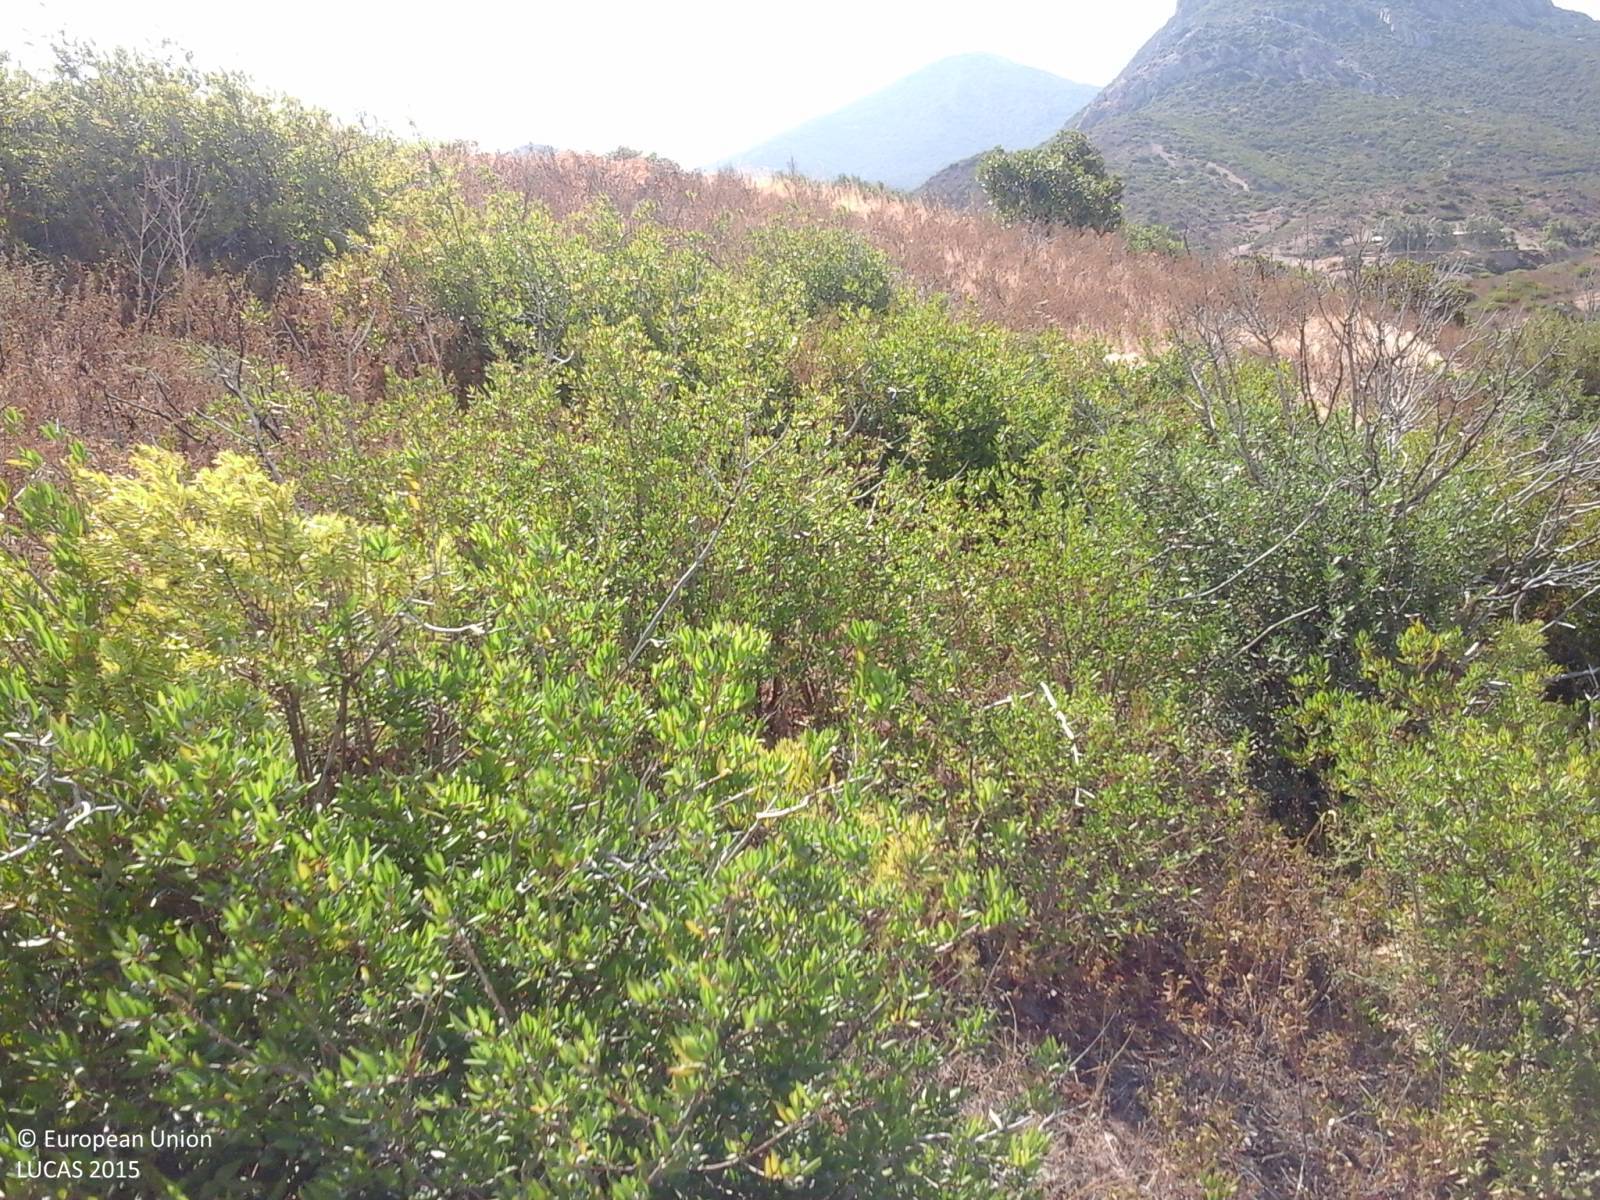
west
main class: Shrubland
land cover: Shrubland without tree cover
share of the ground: > 75 %
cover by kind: shrubs 100 %
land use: Agriculture (excluding fallow land and kitchen gardens)
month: August
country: IT
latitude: 39.3343
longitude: 8.6508
